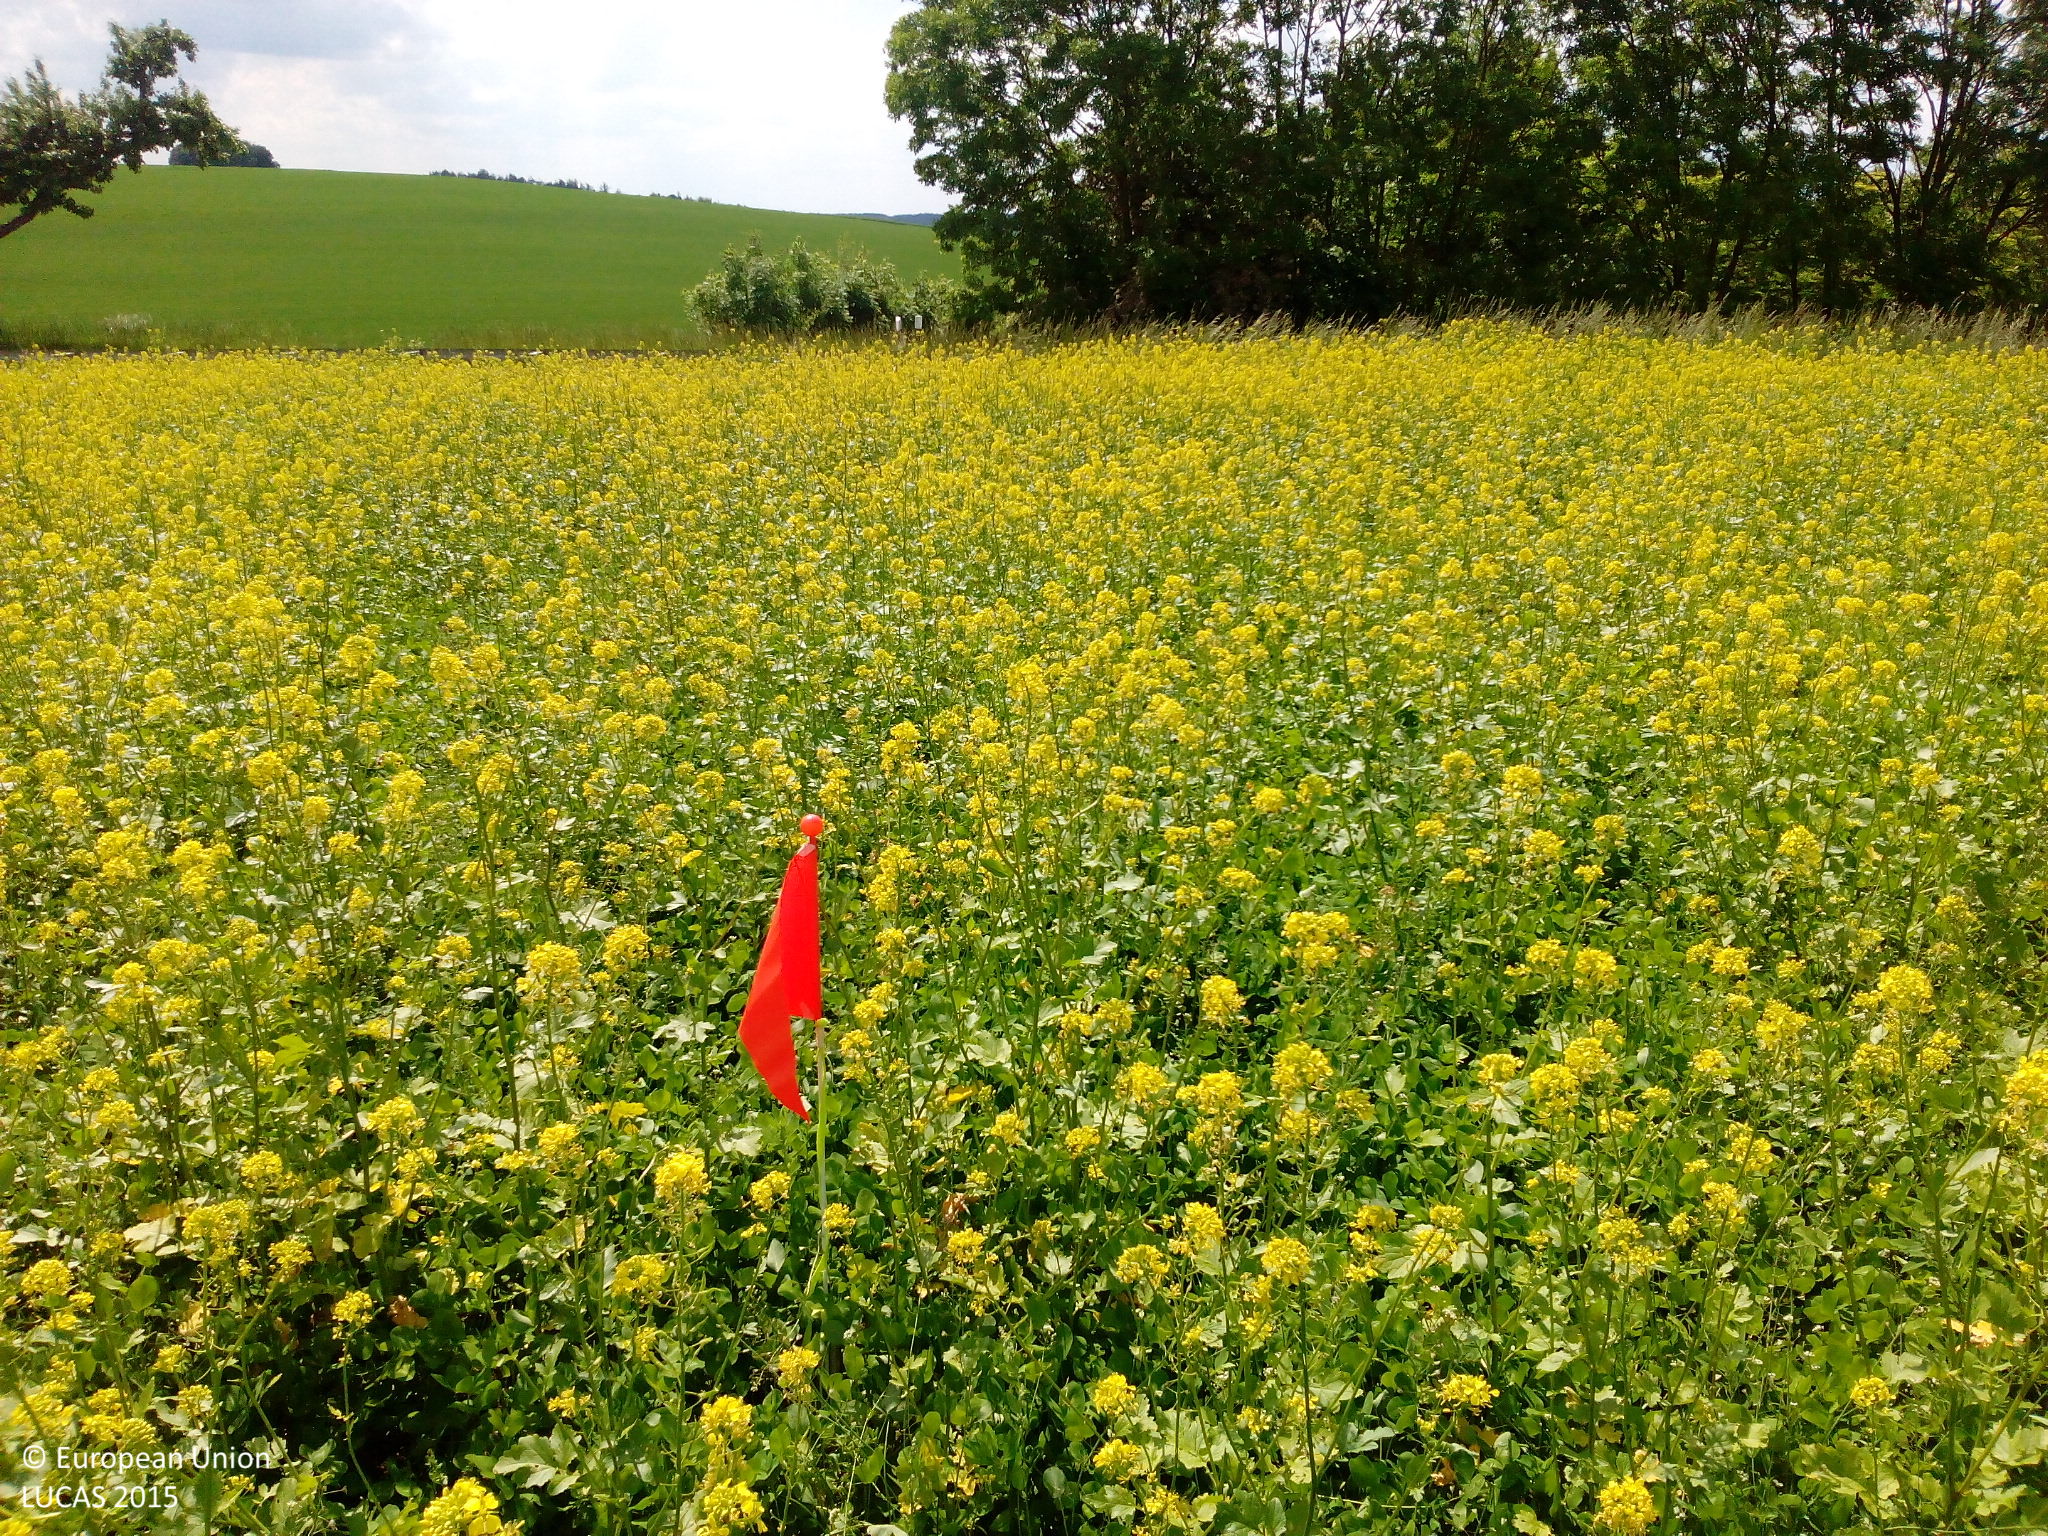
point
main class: Cropland
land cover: Rape and turnip rape
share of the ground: > 75 %
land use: Agriculture (excluding fallow land and kitchen gardens)
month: June
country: DE
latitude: 48.8547
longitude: 11.9210
